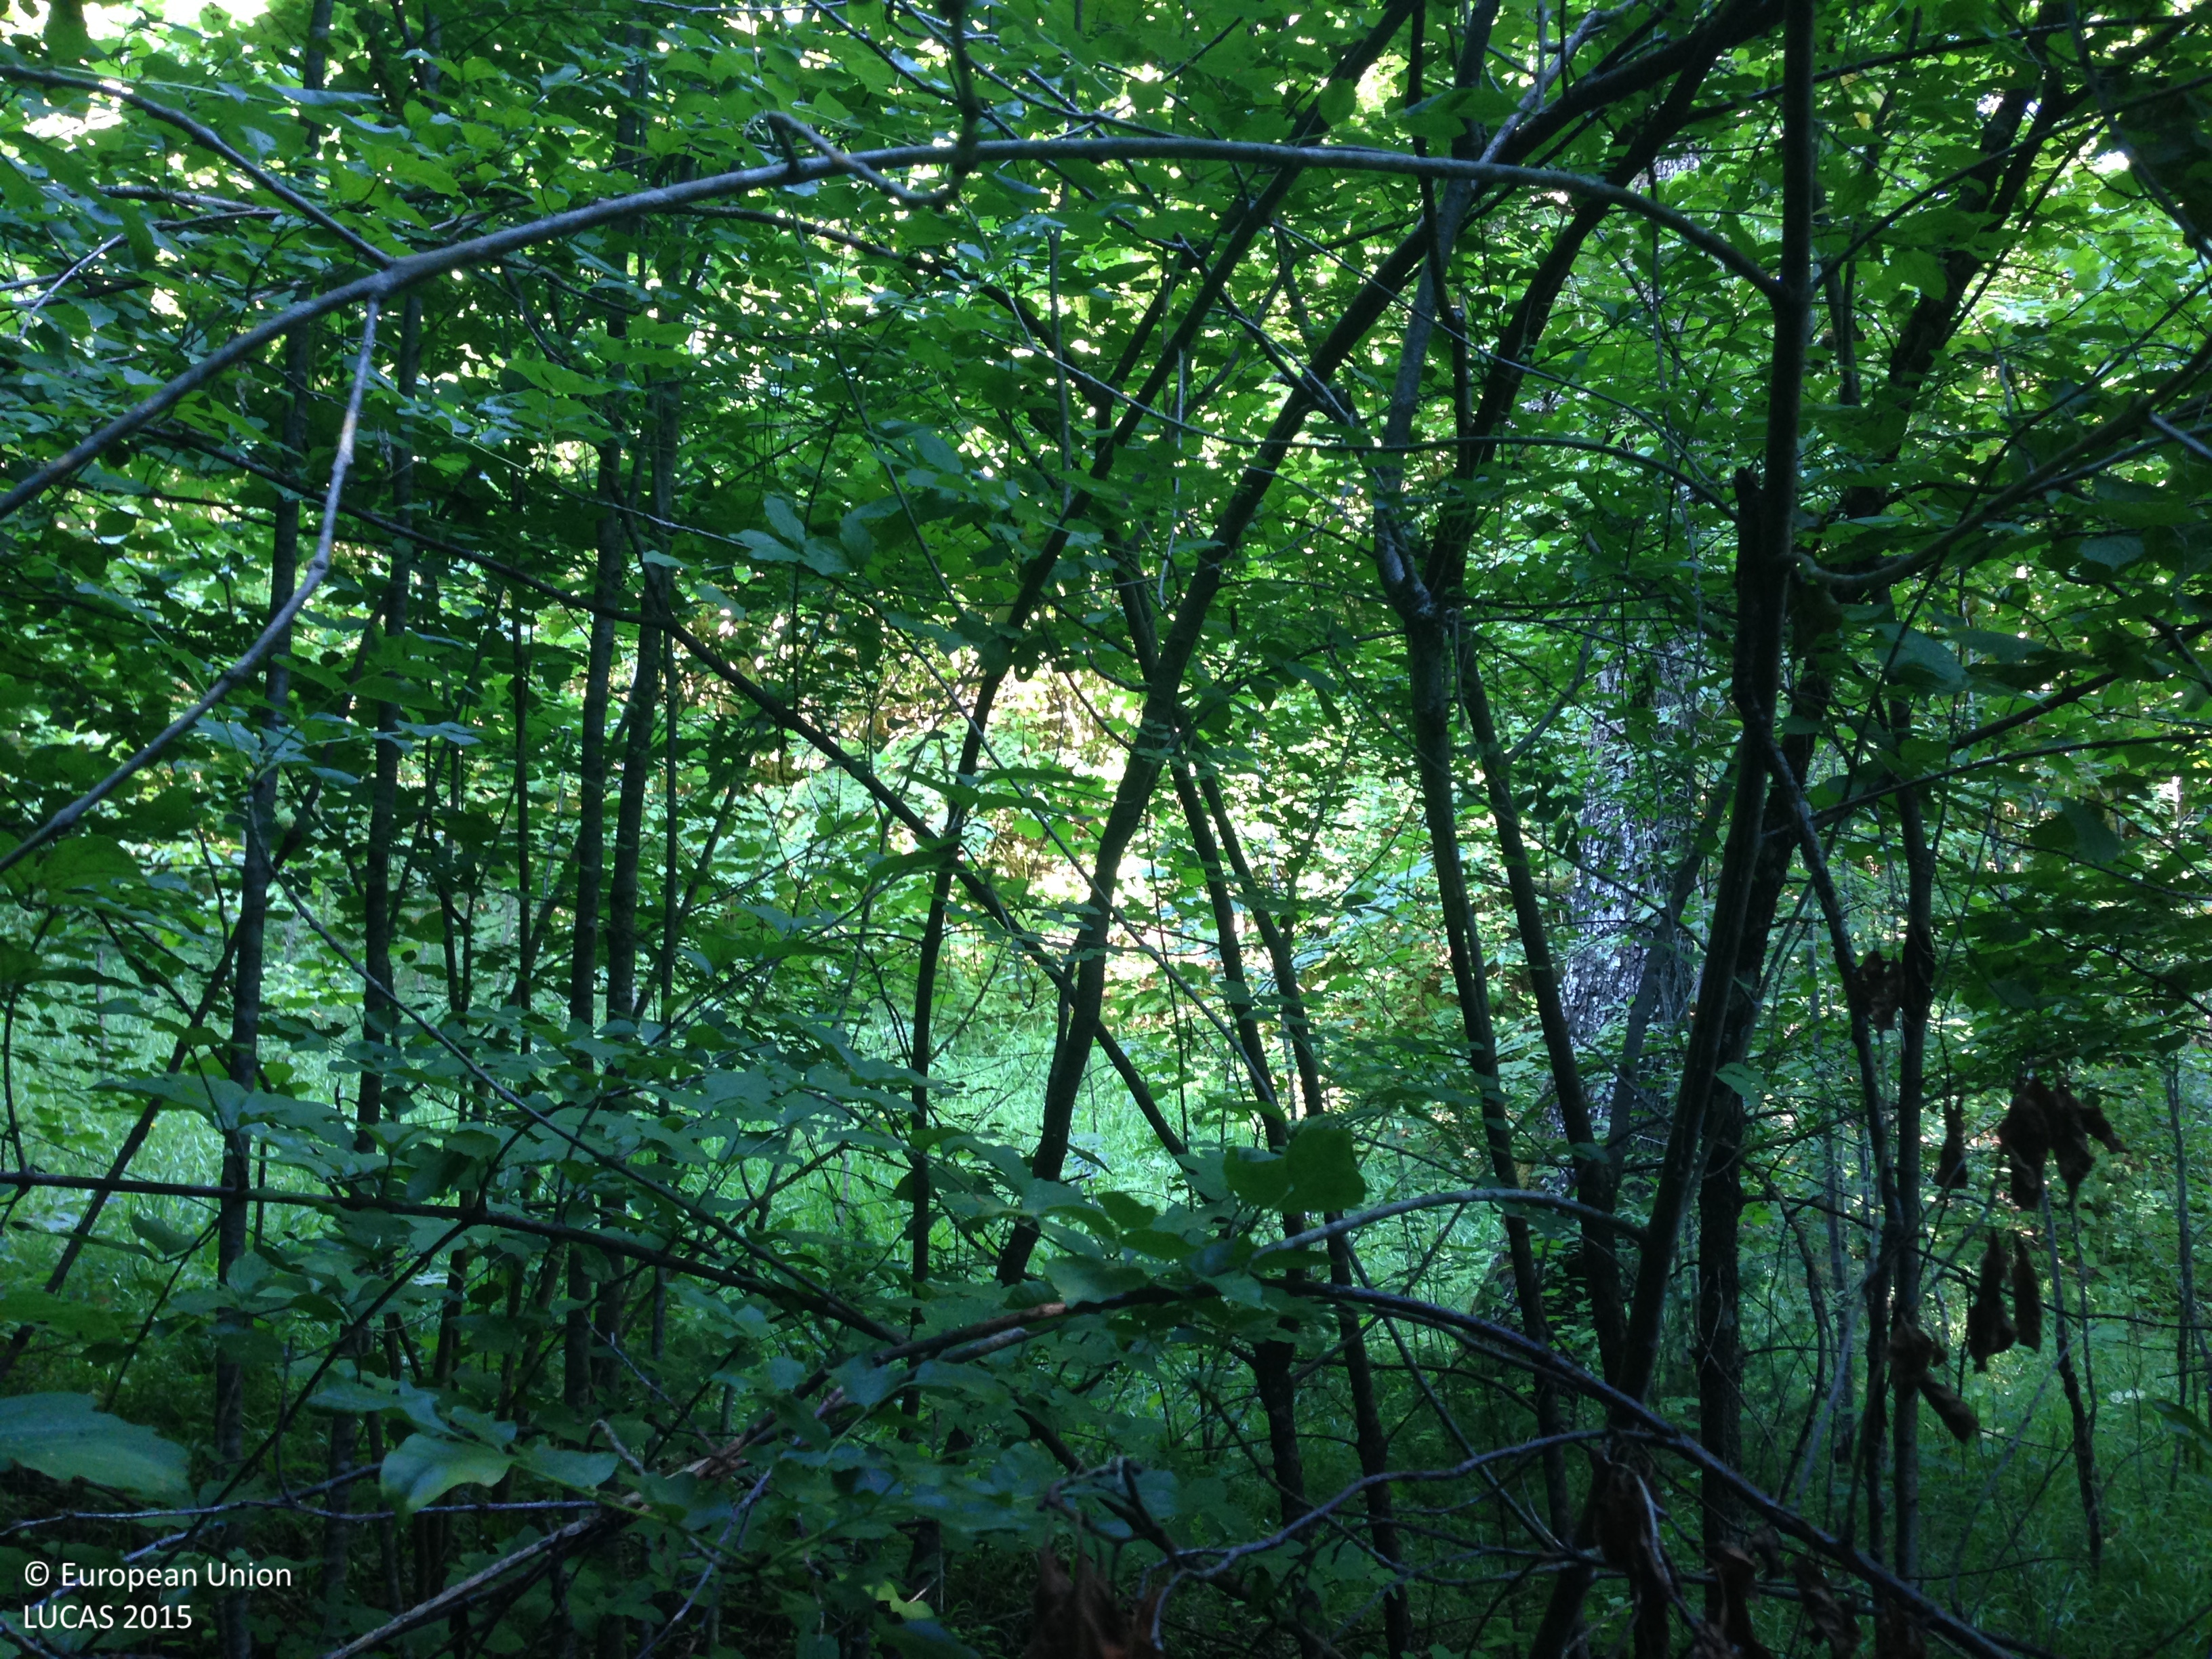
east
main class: Woodland
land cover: Broadleaved woodland
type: beech forest
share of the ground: 50 - 75 %
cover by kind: broadleaved forest trees 60 %, shrubs 30 %, lichens and mosses 5 %, consolidated bare surface 5 %
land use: Semi-natural and natural areas not in use
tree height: > 5 m
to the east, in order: Broadleaved woodland; Ditches and canals; Broadleaved woodland
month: July
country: HR
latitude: 44.7102
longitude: 15.1562
